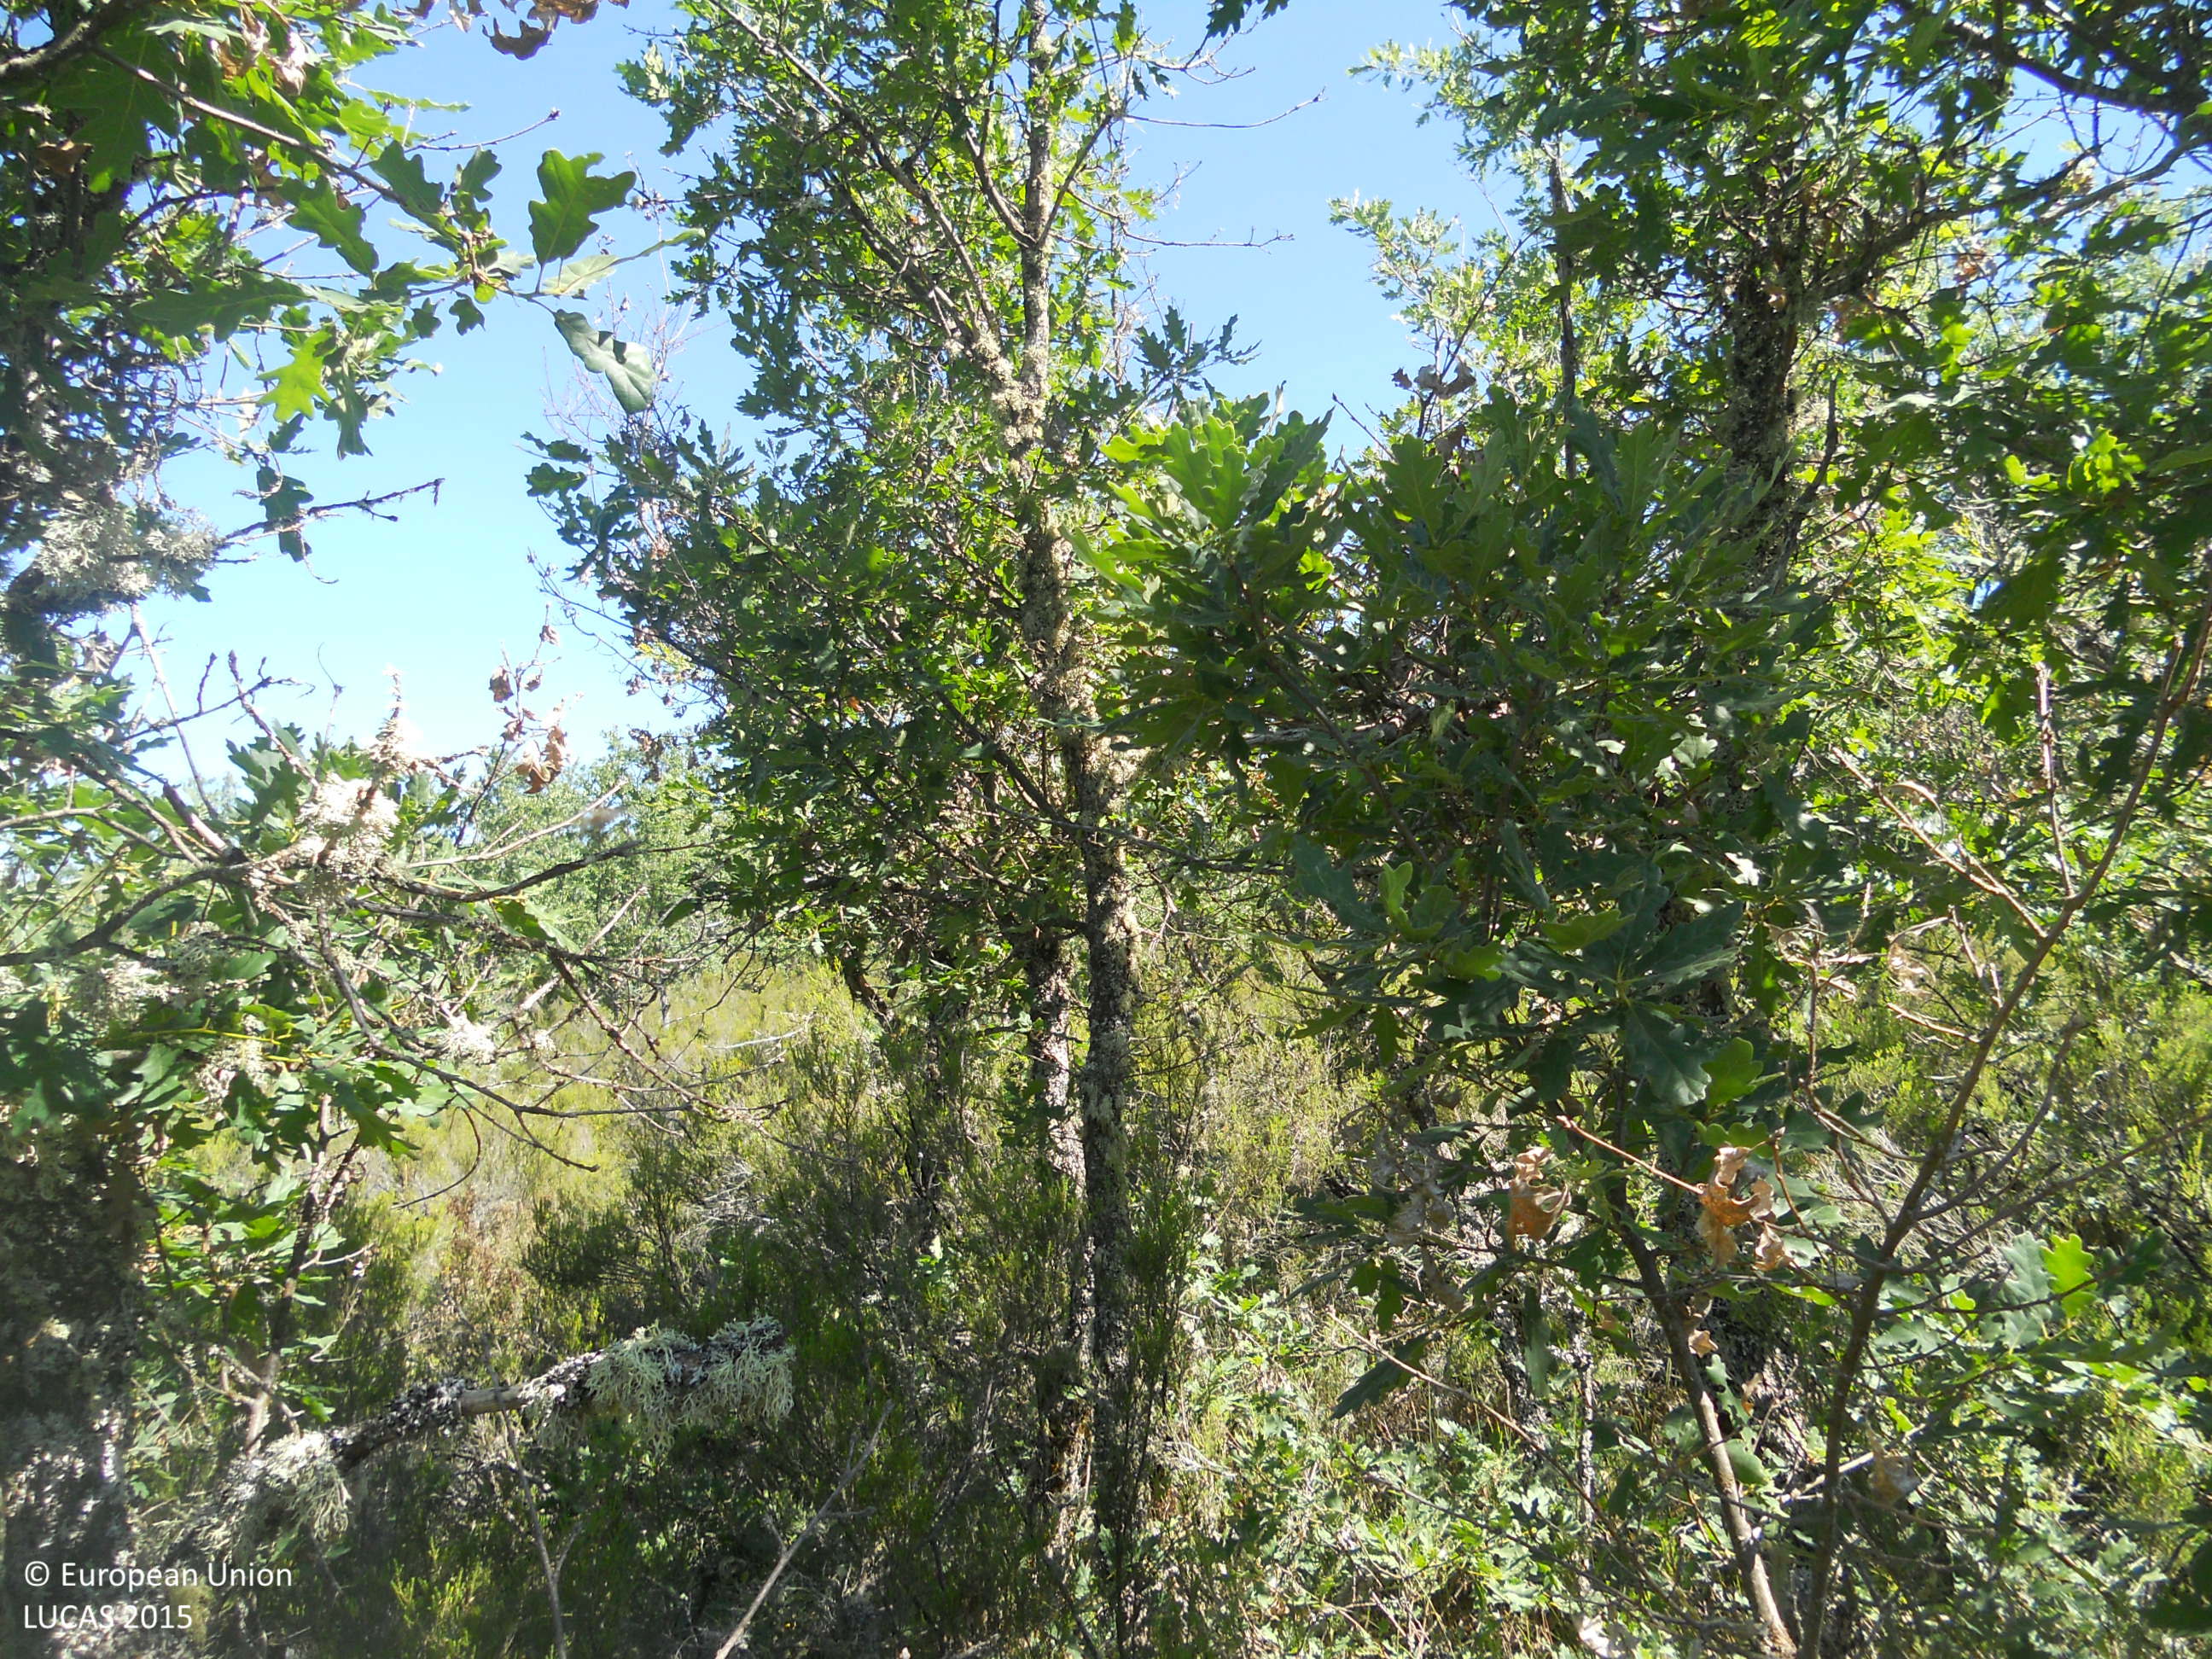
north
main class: Woodland
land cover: Broadleaved woodland
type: acidophilous oak and oak-birch forest
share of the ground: 50 - 75 %
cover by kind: broadleaved forest trees 70 %, shrubs 25 %, herbaceous plants 5 %
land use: Forestry
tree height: > 5 m
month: June
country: ES
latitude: 42.6194
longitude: -4.9467
